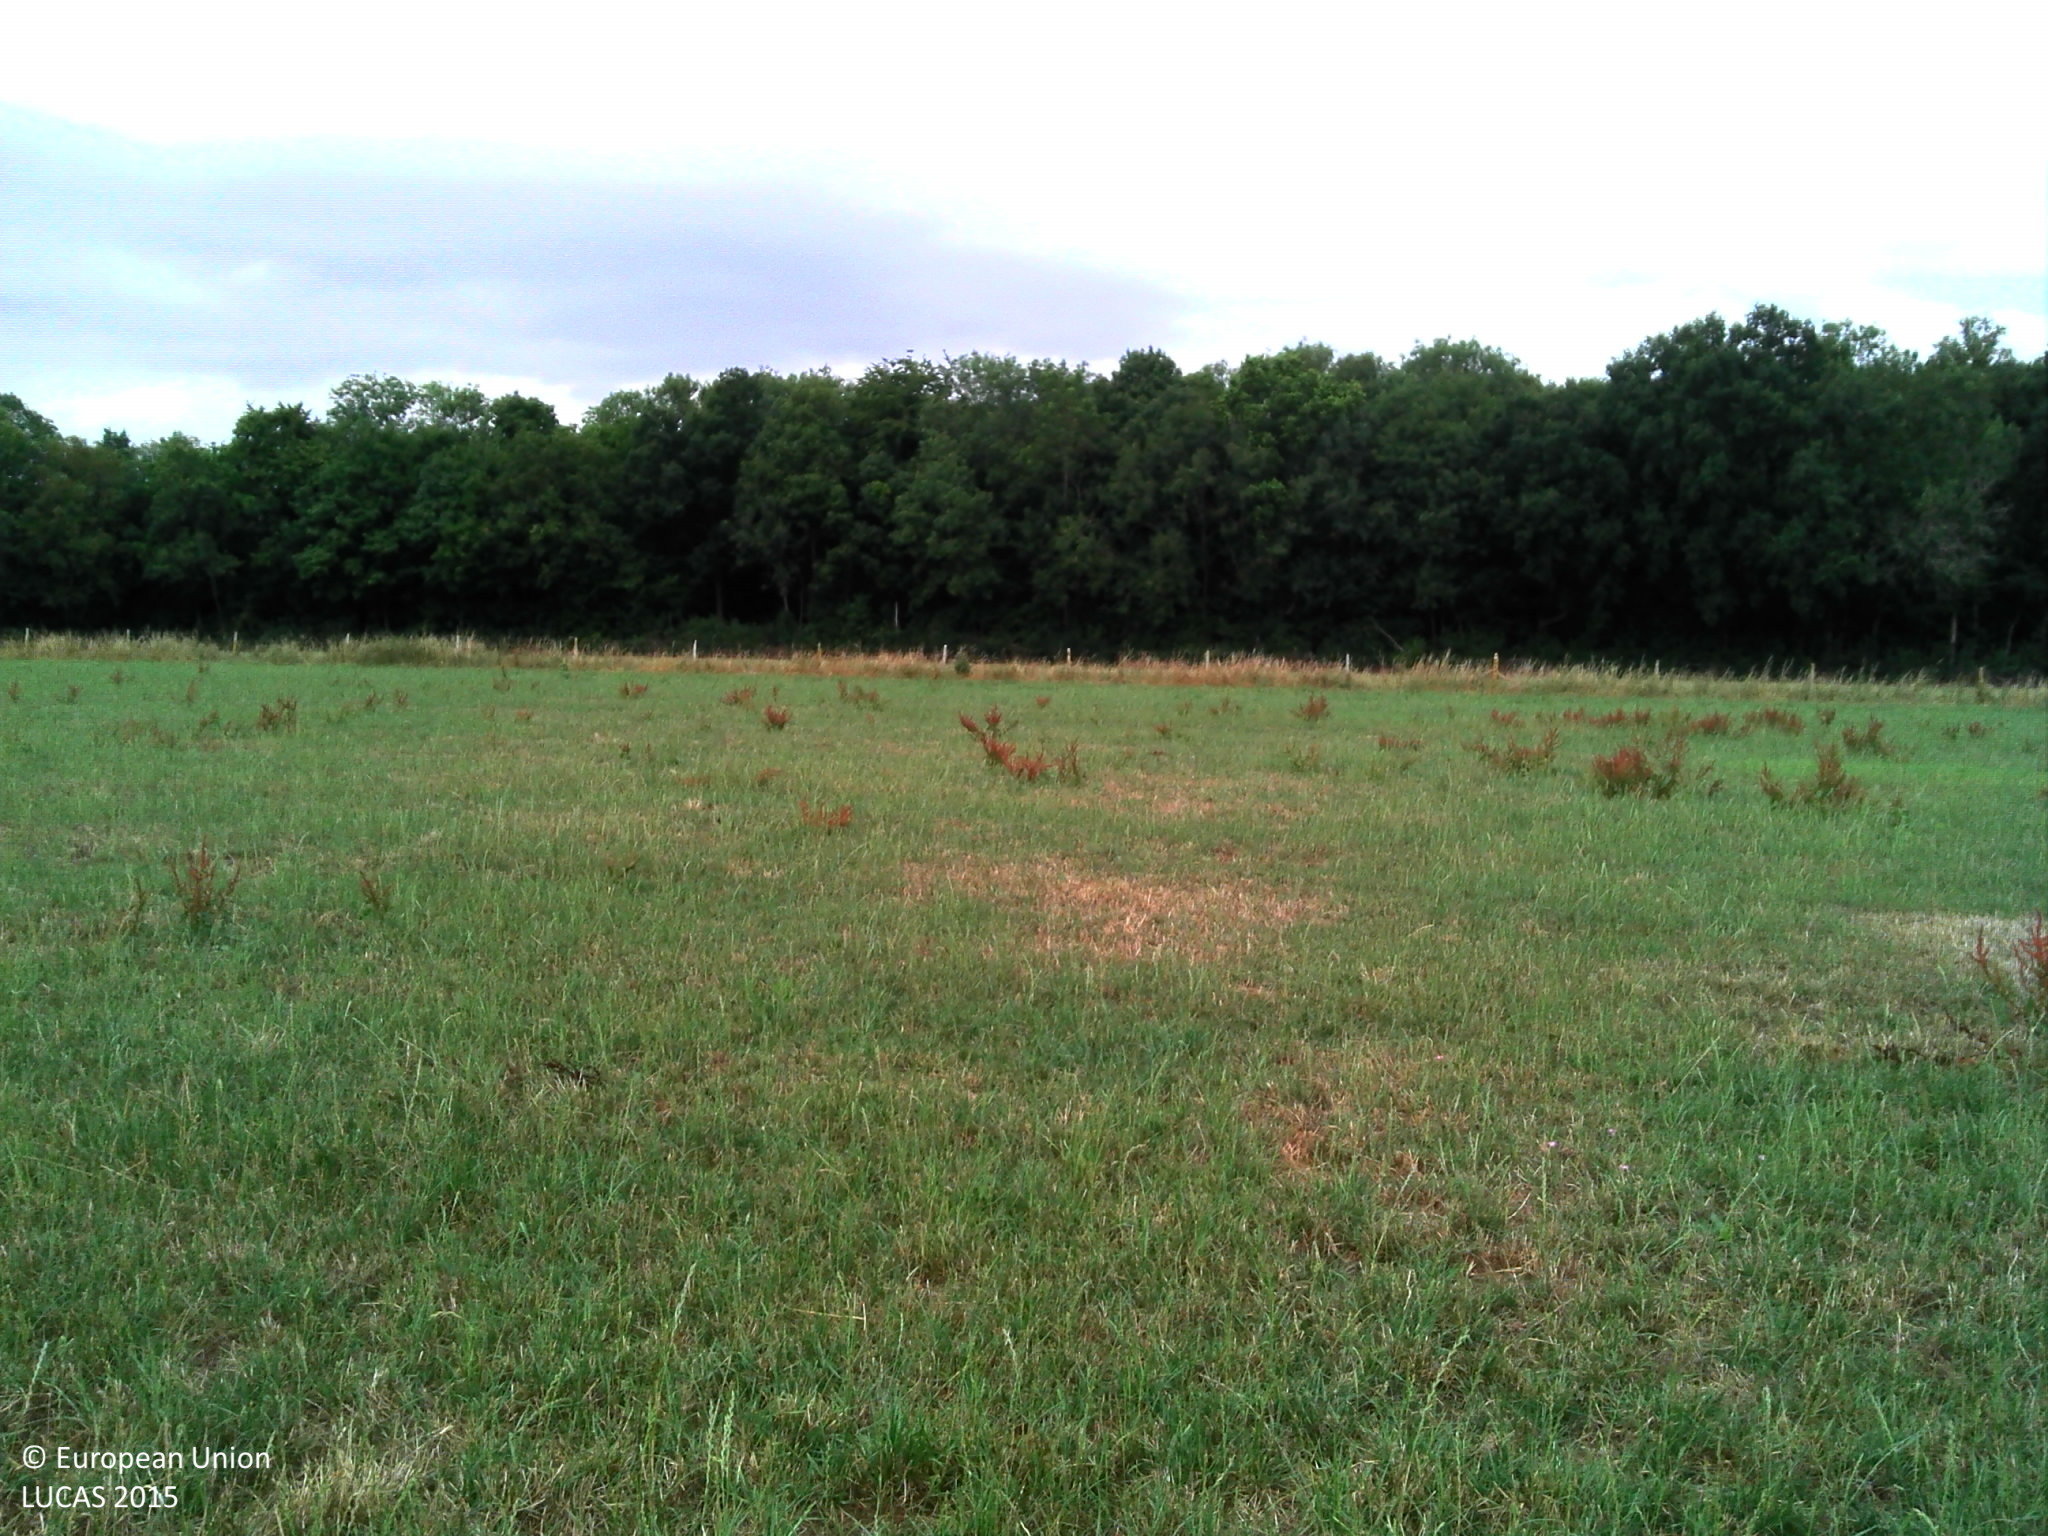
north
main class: Grassland
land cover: Grassland without tree/shrub cover
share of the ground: > 75 %
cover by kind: herbaceous plants 100 %
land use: Agriculture (excluding fallow land and kitchen gardens)
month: July
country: FR
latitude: 49.8153
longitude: 2.3011
